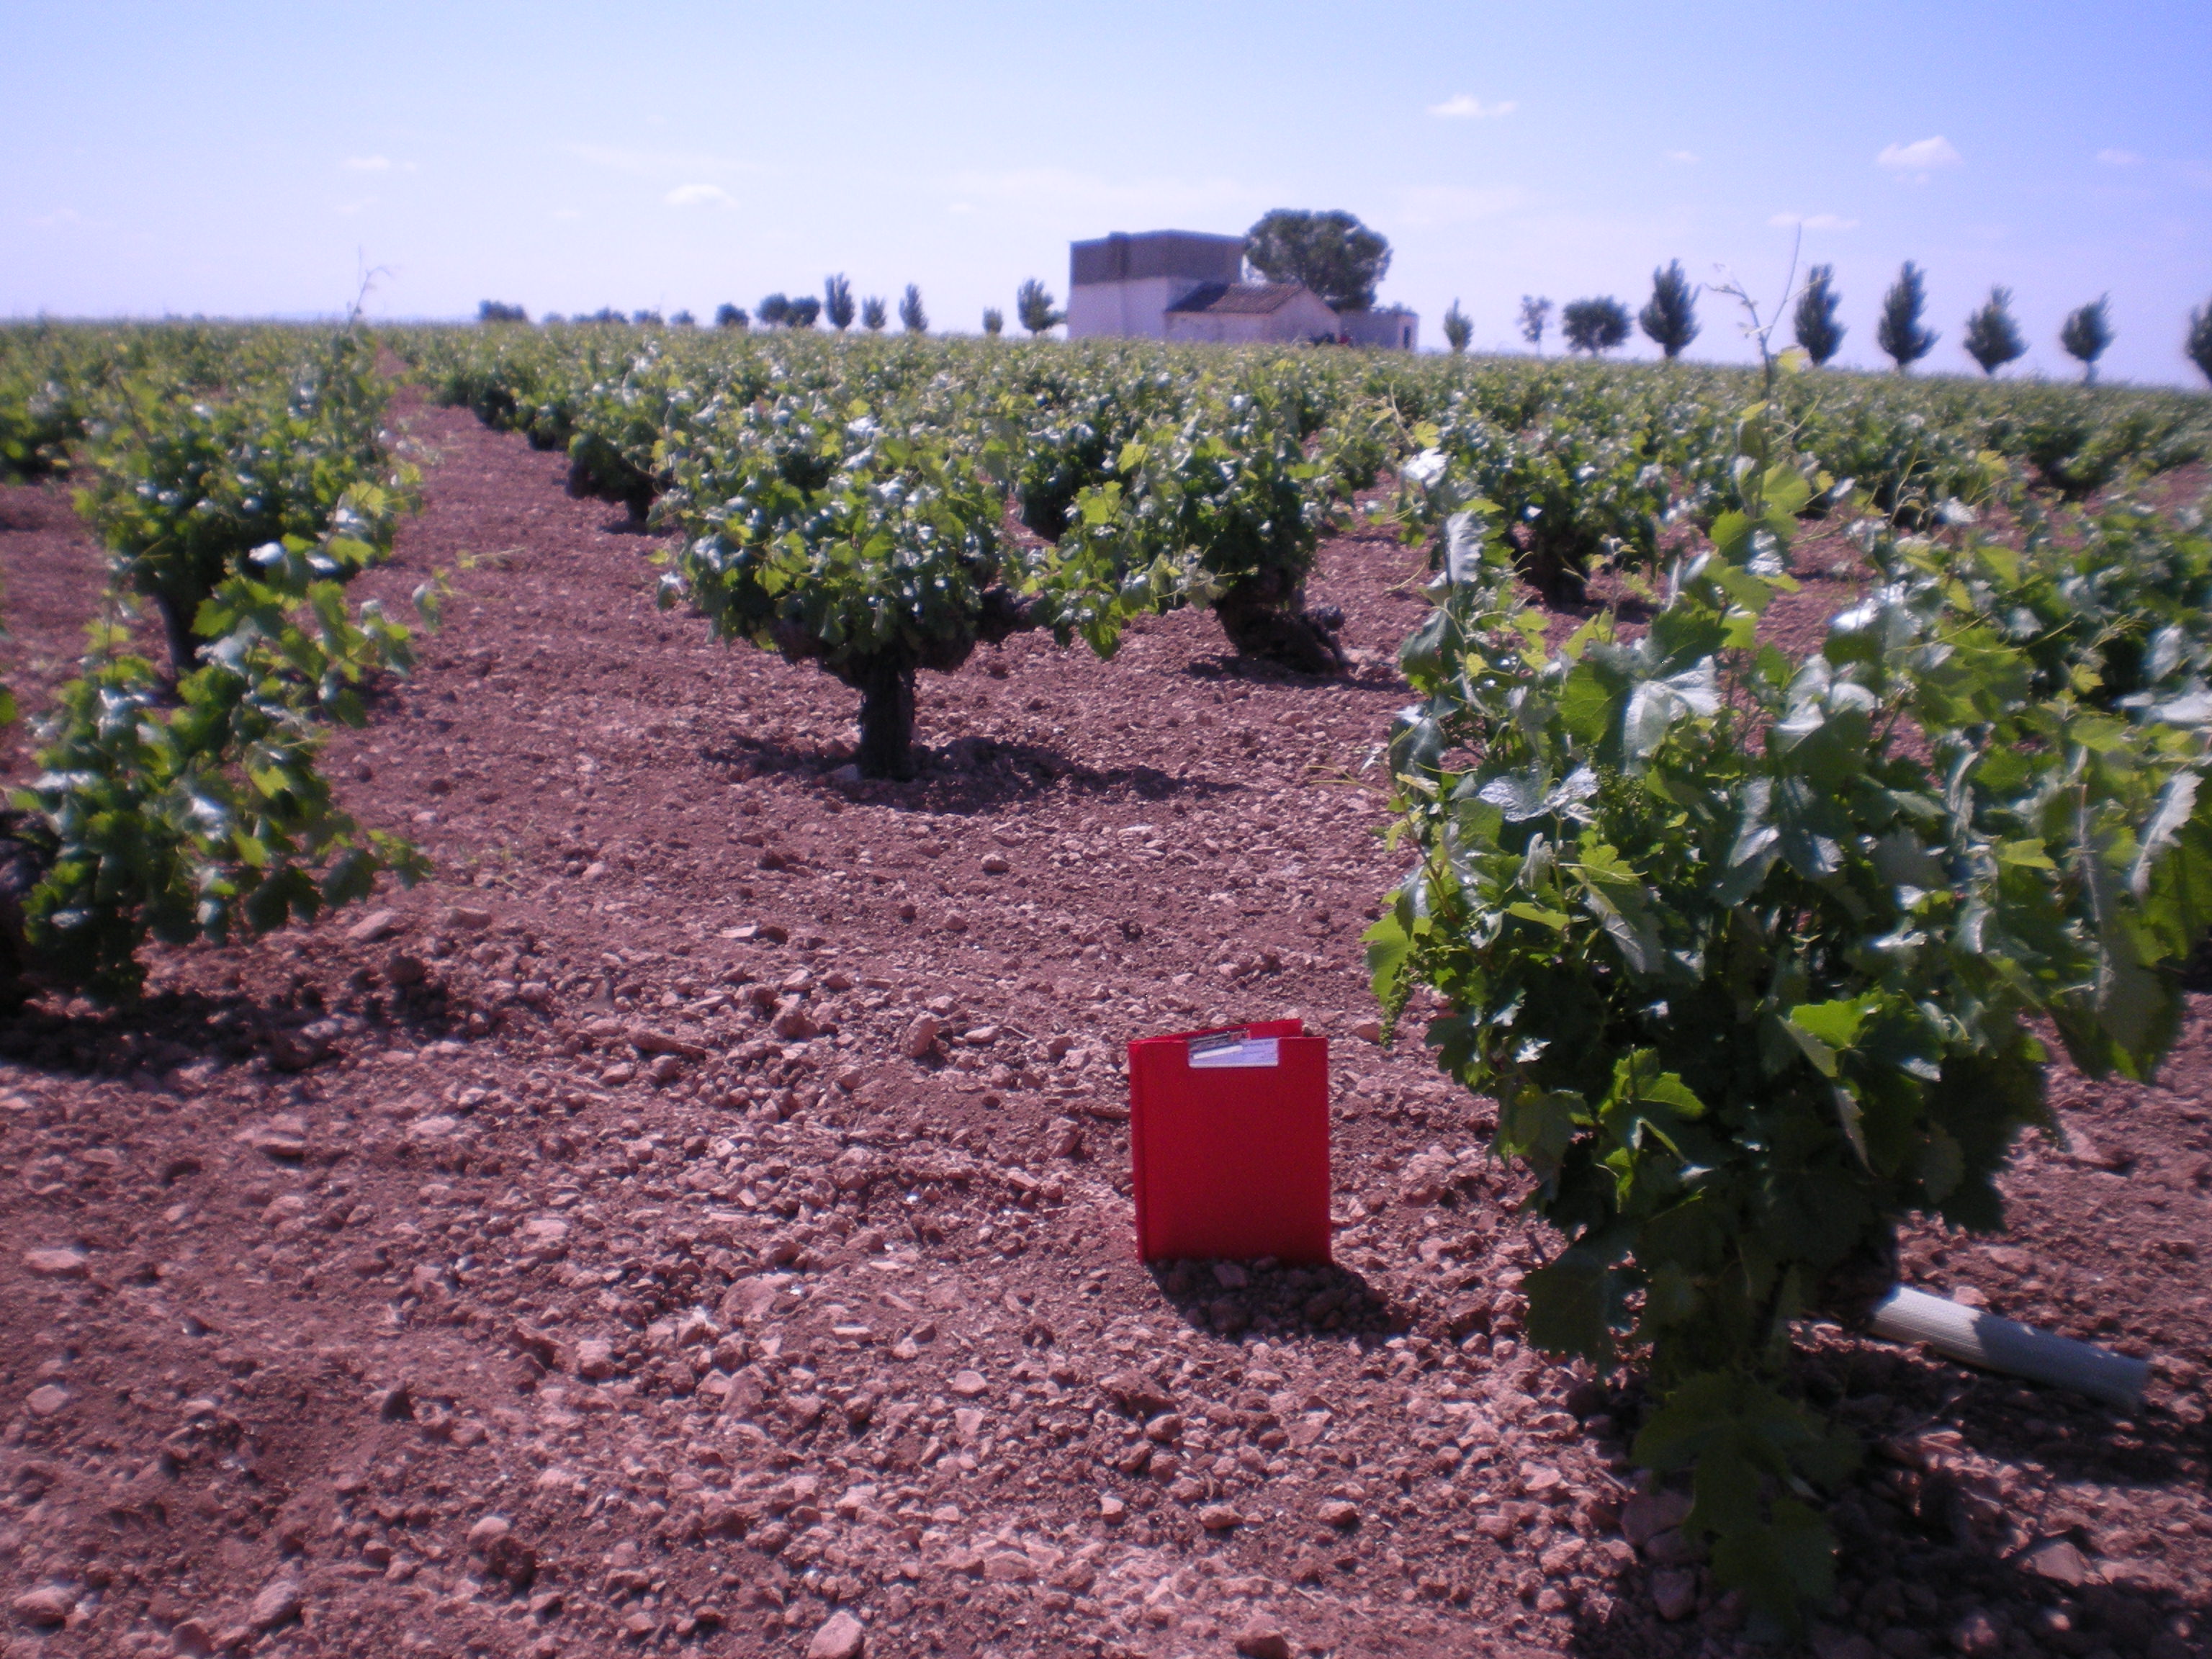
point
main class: Cropland
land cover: Vineyards
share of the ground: 10 - 25 %
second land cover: Other bare soil
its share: > 75 %
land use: Agriculture (excluding fallow land and kitchen gardens)
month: May
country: ES
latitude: 39.0933
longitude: -3.4864
